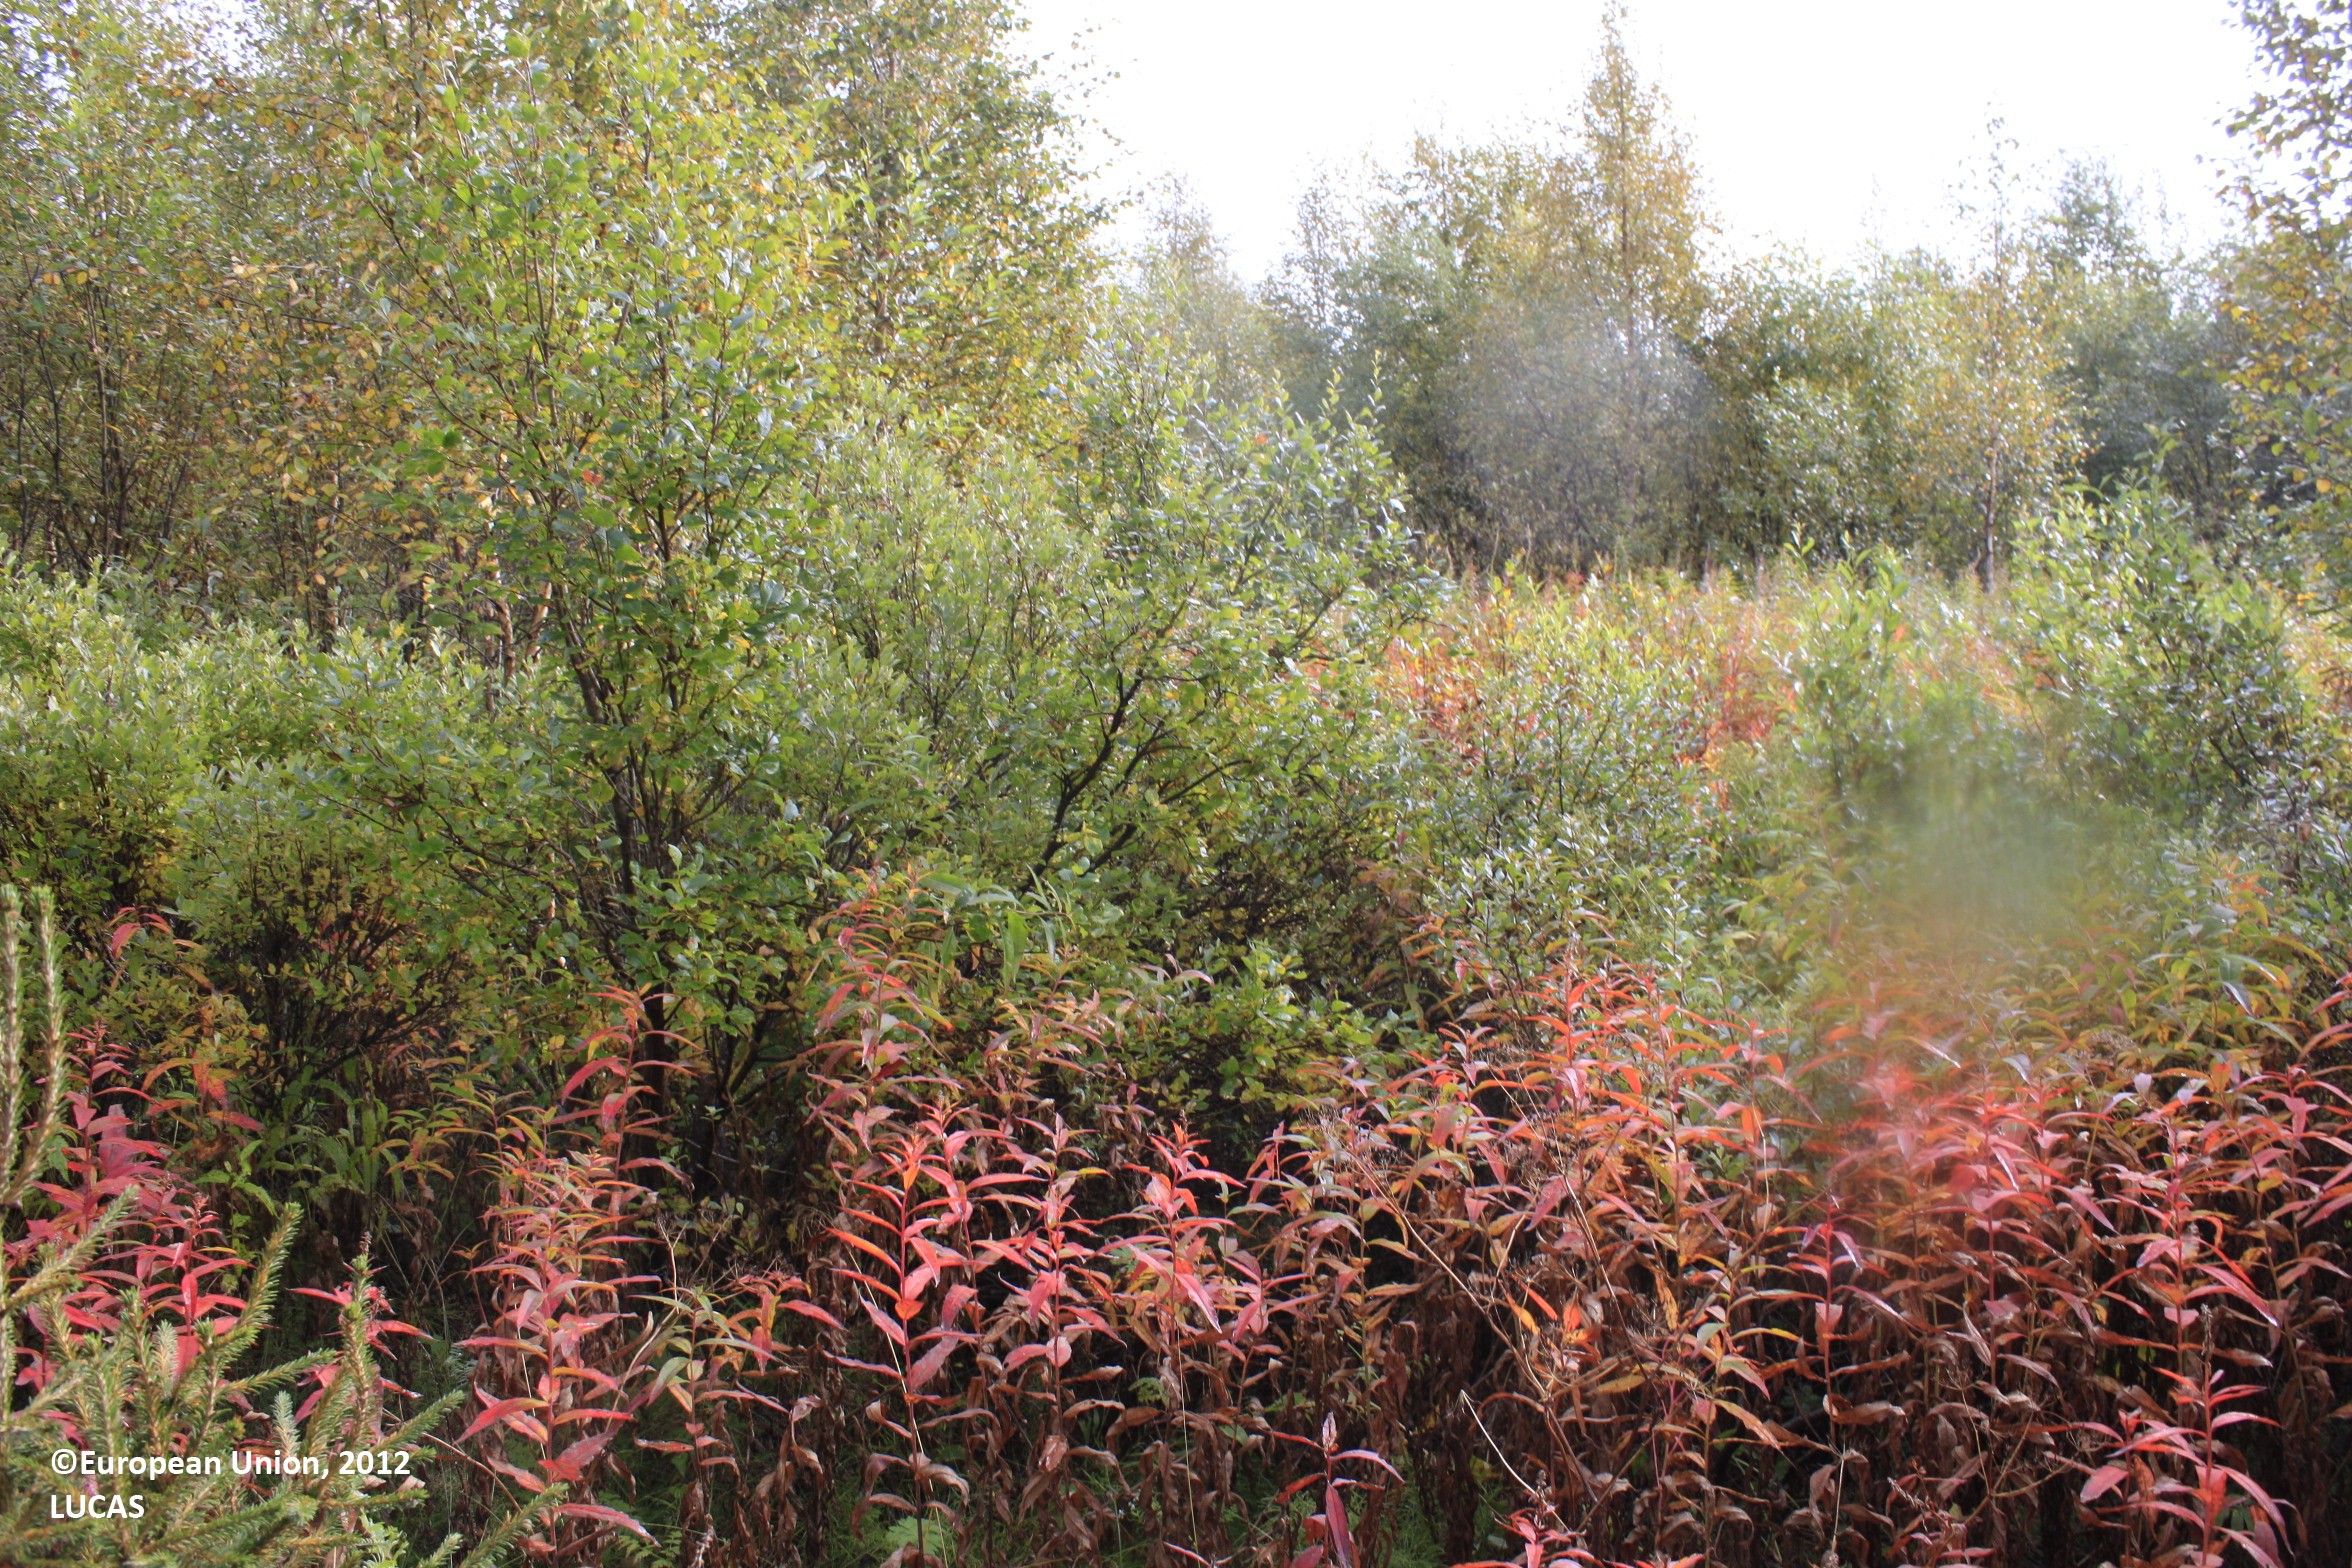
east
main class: Shrubland
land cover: Shrubland with sparse tree cover
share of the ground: > 75 %
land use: Semi-natural and natural areas not in use
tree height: > 5 m
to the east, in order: Shrubland with sparse tree cover; Pine dominated mixed woodland; Inland running water; Grassland without tree/shrub cover; Artificial constructions in urban areas; Pine dominated mixed woodland; Fences; Grassland without tree/shrub cover; Ditches and canals; Tracks
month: September
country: FI
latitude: 65.5755
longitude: 26.5966
